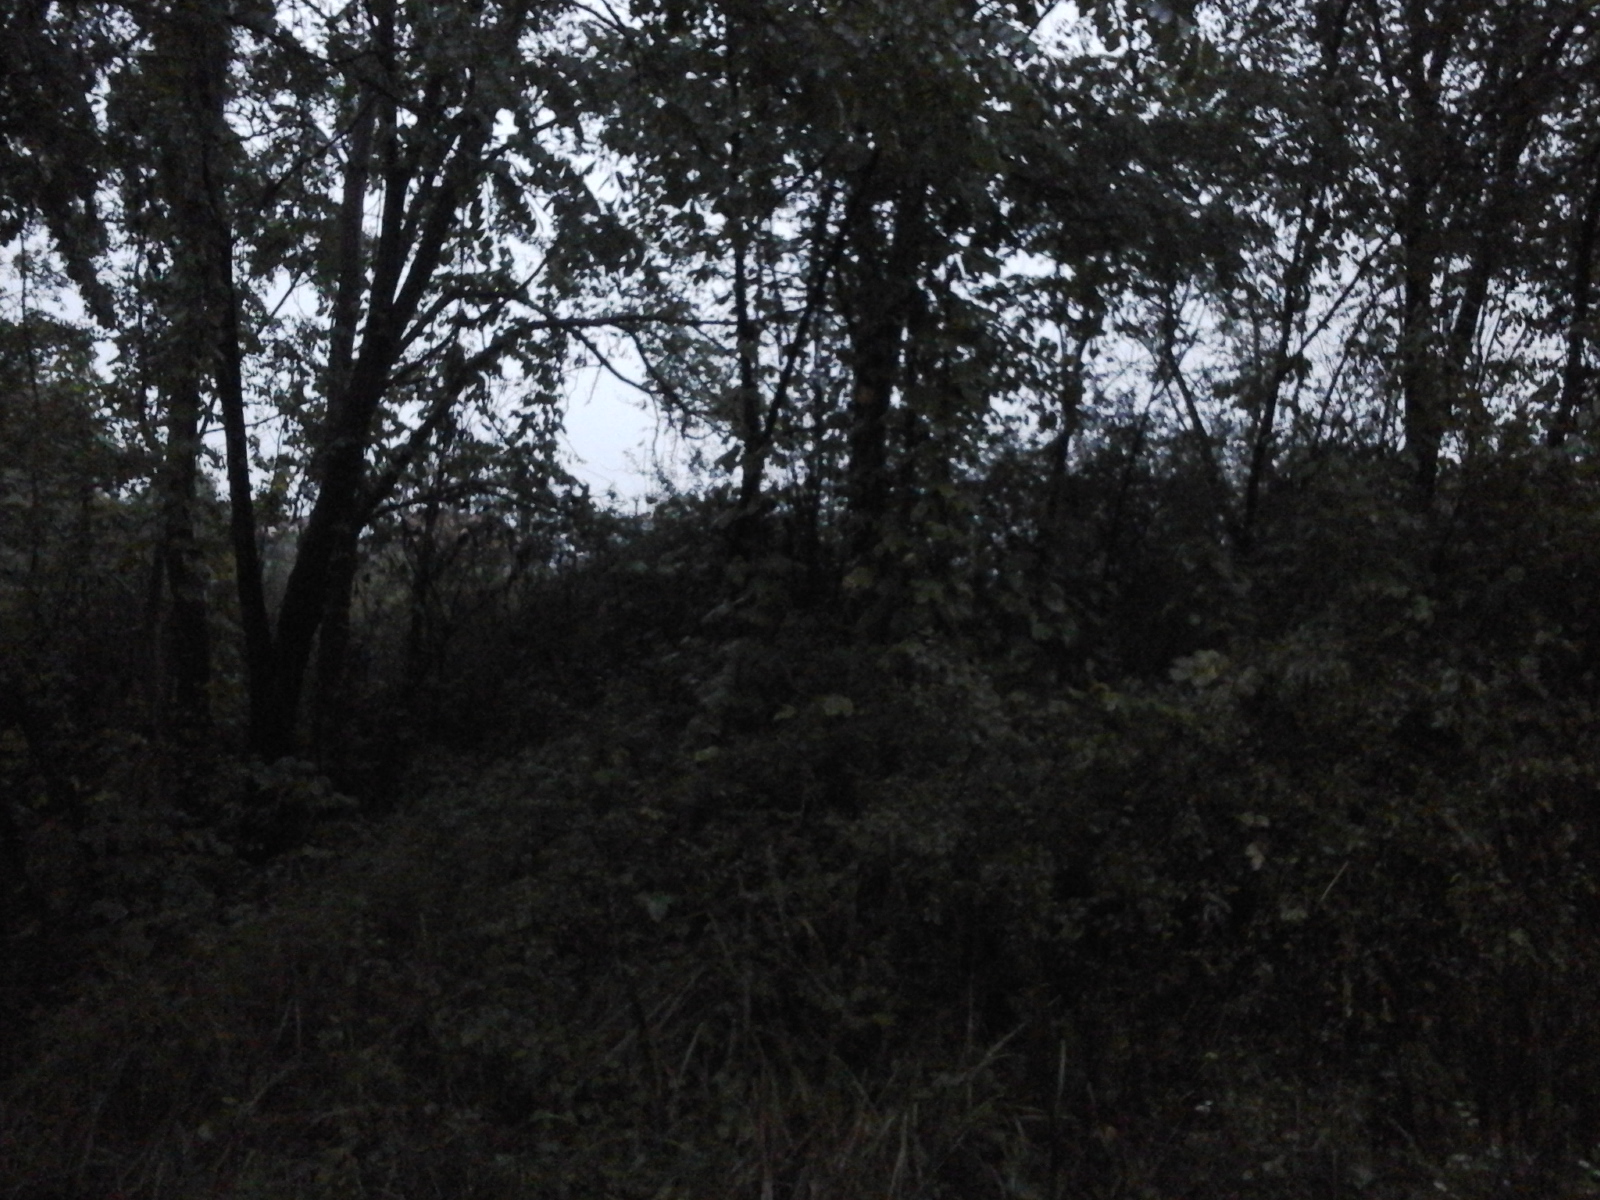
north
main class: Woodland
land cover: Broadleaved woodland
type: beech forest
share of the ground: > 75 %
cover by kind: broadleaved forest trees 100 %
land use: Forestry
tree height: > 5 m
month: September
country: RO
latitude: 44.9617
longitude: 23.6368
